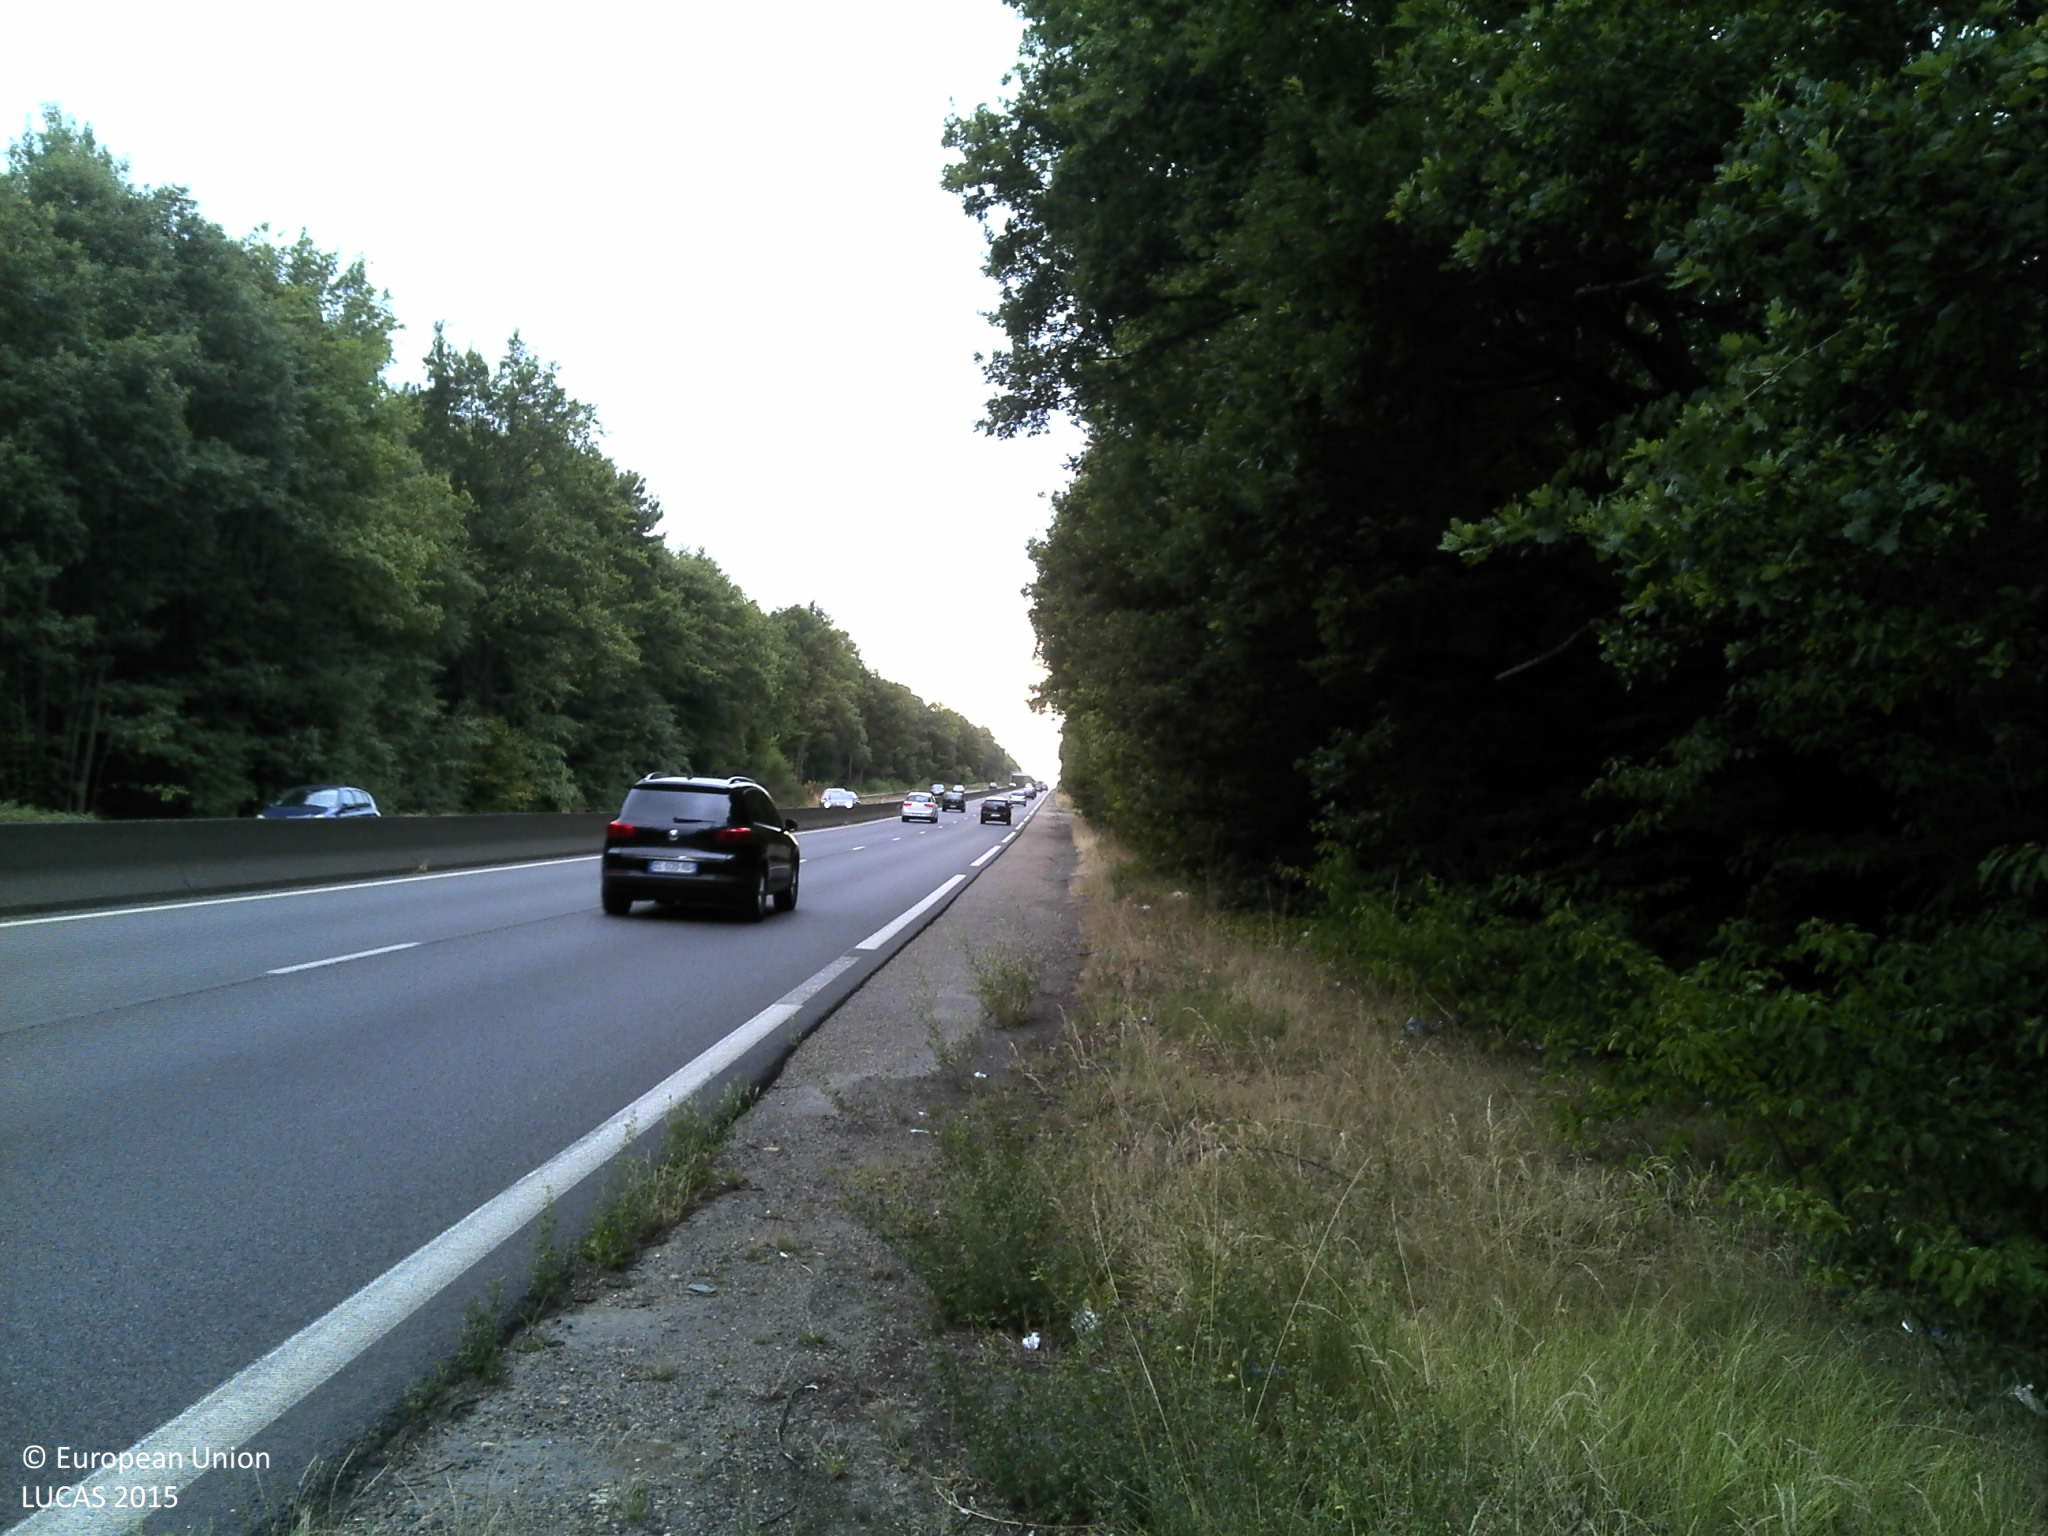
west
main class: Woodland
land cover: Pine dominated mixed woodland
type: hemiboreal forest and nemoral coniferous forest and mixed broadleaved-coniferous forest
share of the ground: > 75 %
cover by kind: broadleaved forest trees 55 %, coniferous forest trees 35 %, herbaceous plants 10 %
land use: Forestry
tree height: > 5 m
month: July
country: FR
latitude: 48.6891
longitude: 2.4768
